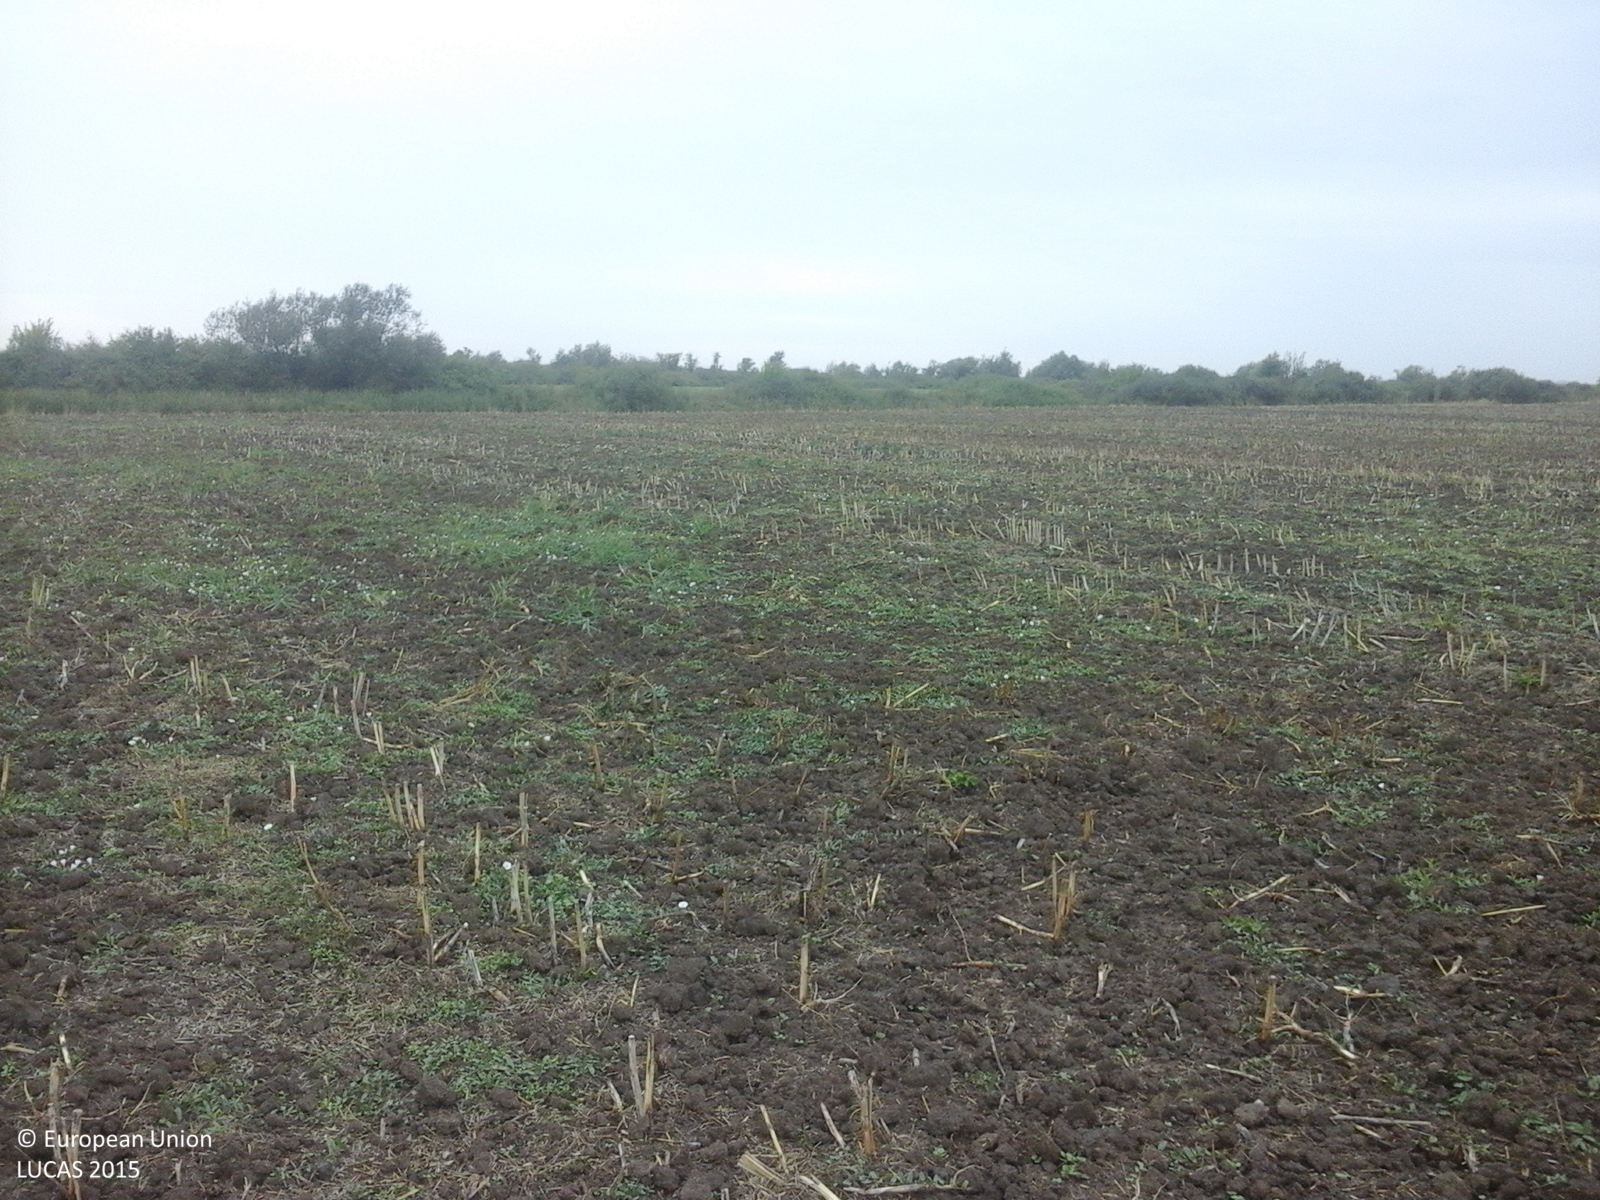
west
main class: Cropland
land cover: Rape and turnip rape
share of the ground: < 10 %
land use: Agriculture (excluding fallow land and kitchen gardens)
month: August
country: RO
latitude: 45.4209
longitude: 20.9782
